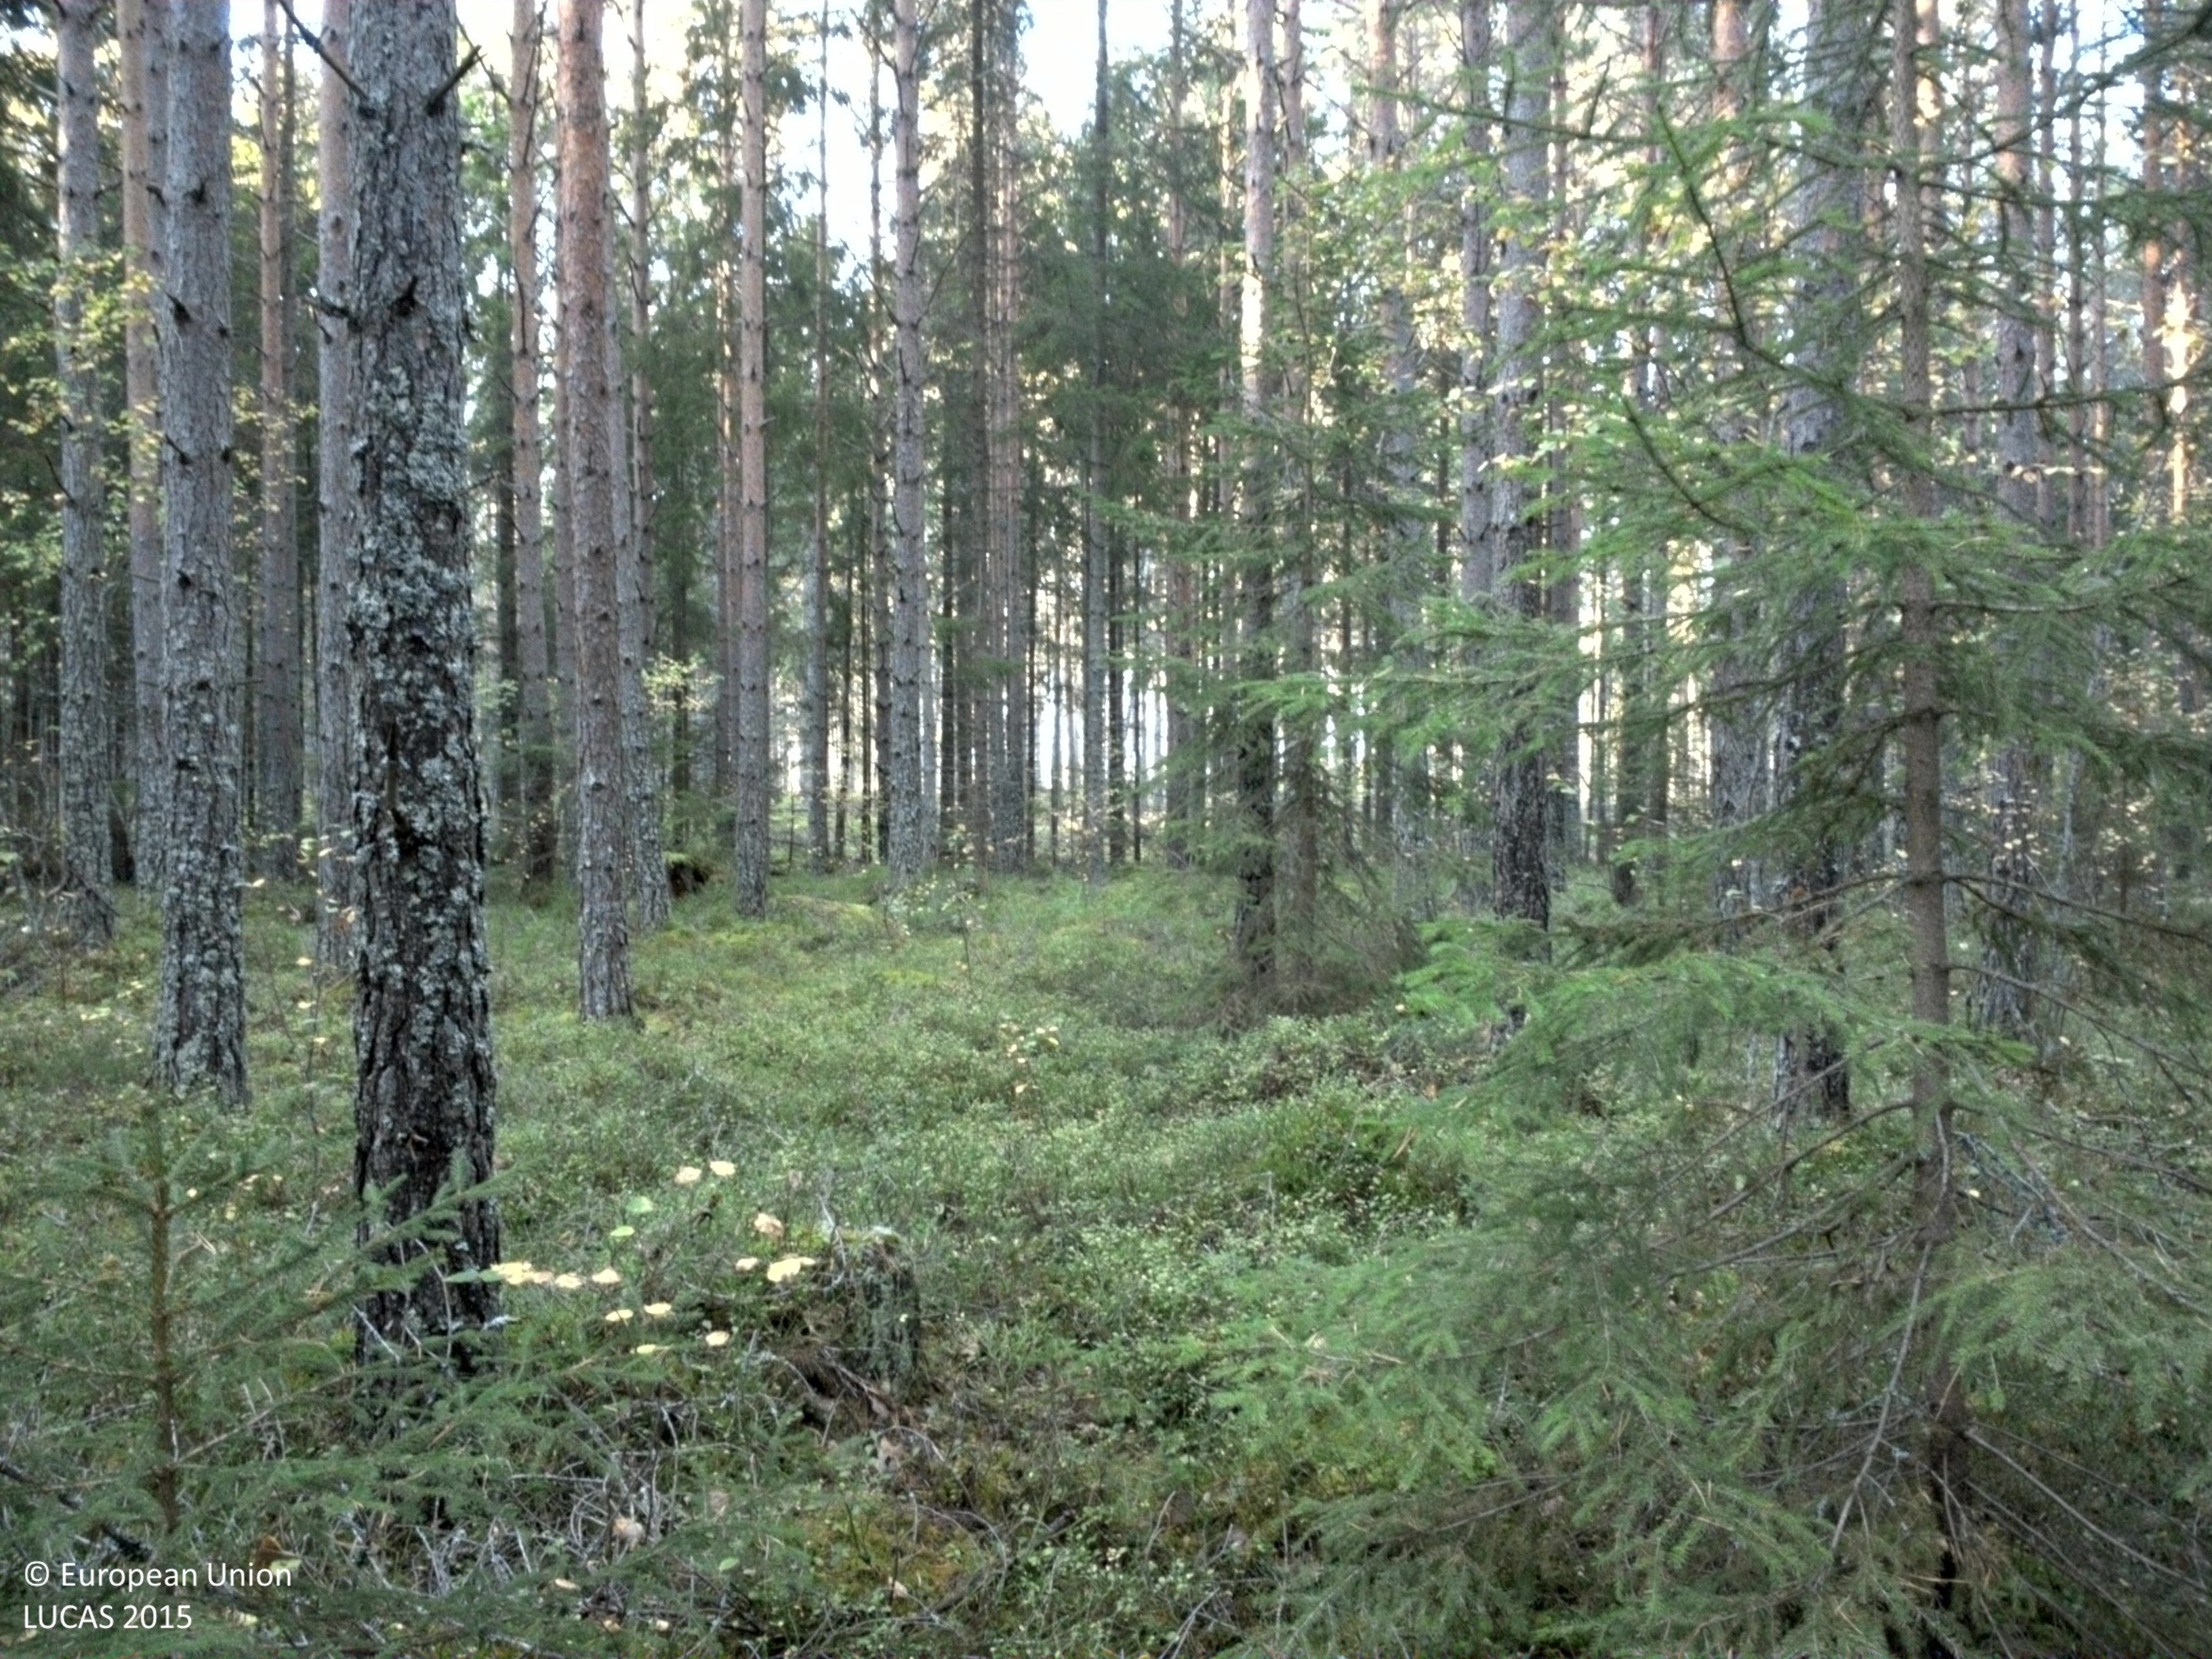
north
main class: Woodland
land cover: Pine dominated coniferous woodland
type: boreal forest
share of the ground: > 75 %
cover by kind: coniferous forest trees 70 %, broadleaved forest trees 15 %, lichens and mosses 15 %
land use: Forestry
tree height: > 5 m
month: September
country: SE
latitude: 59.9931
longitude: 16.5338
